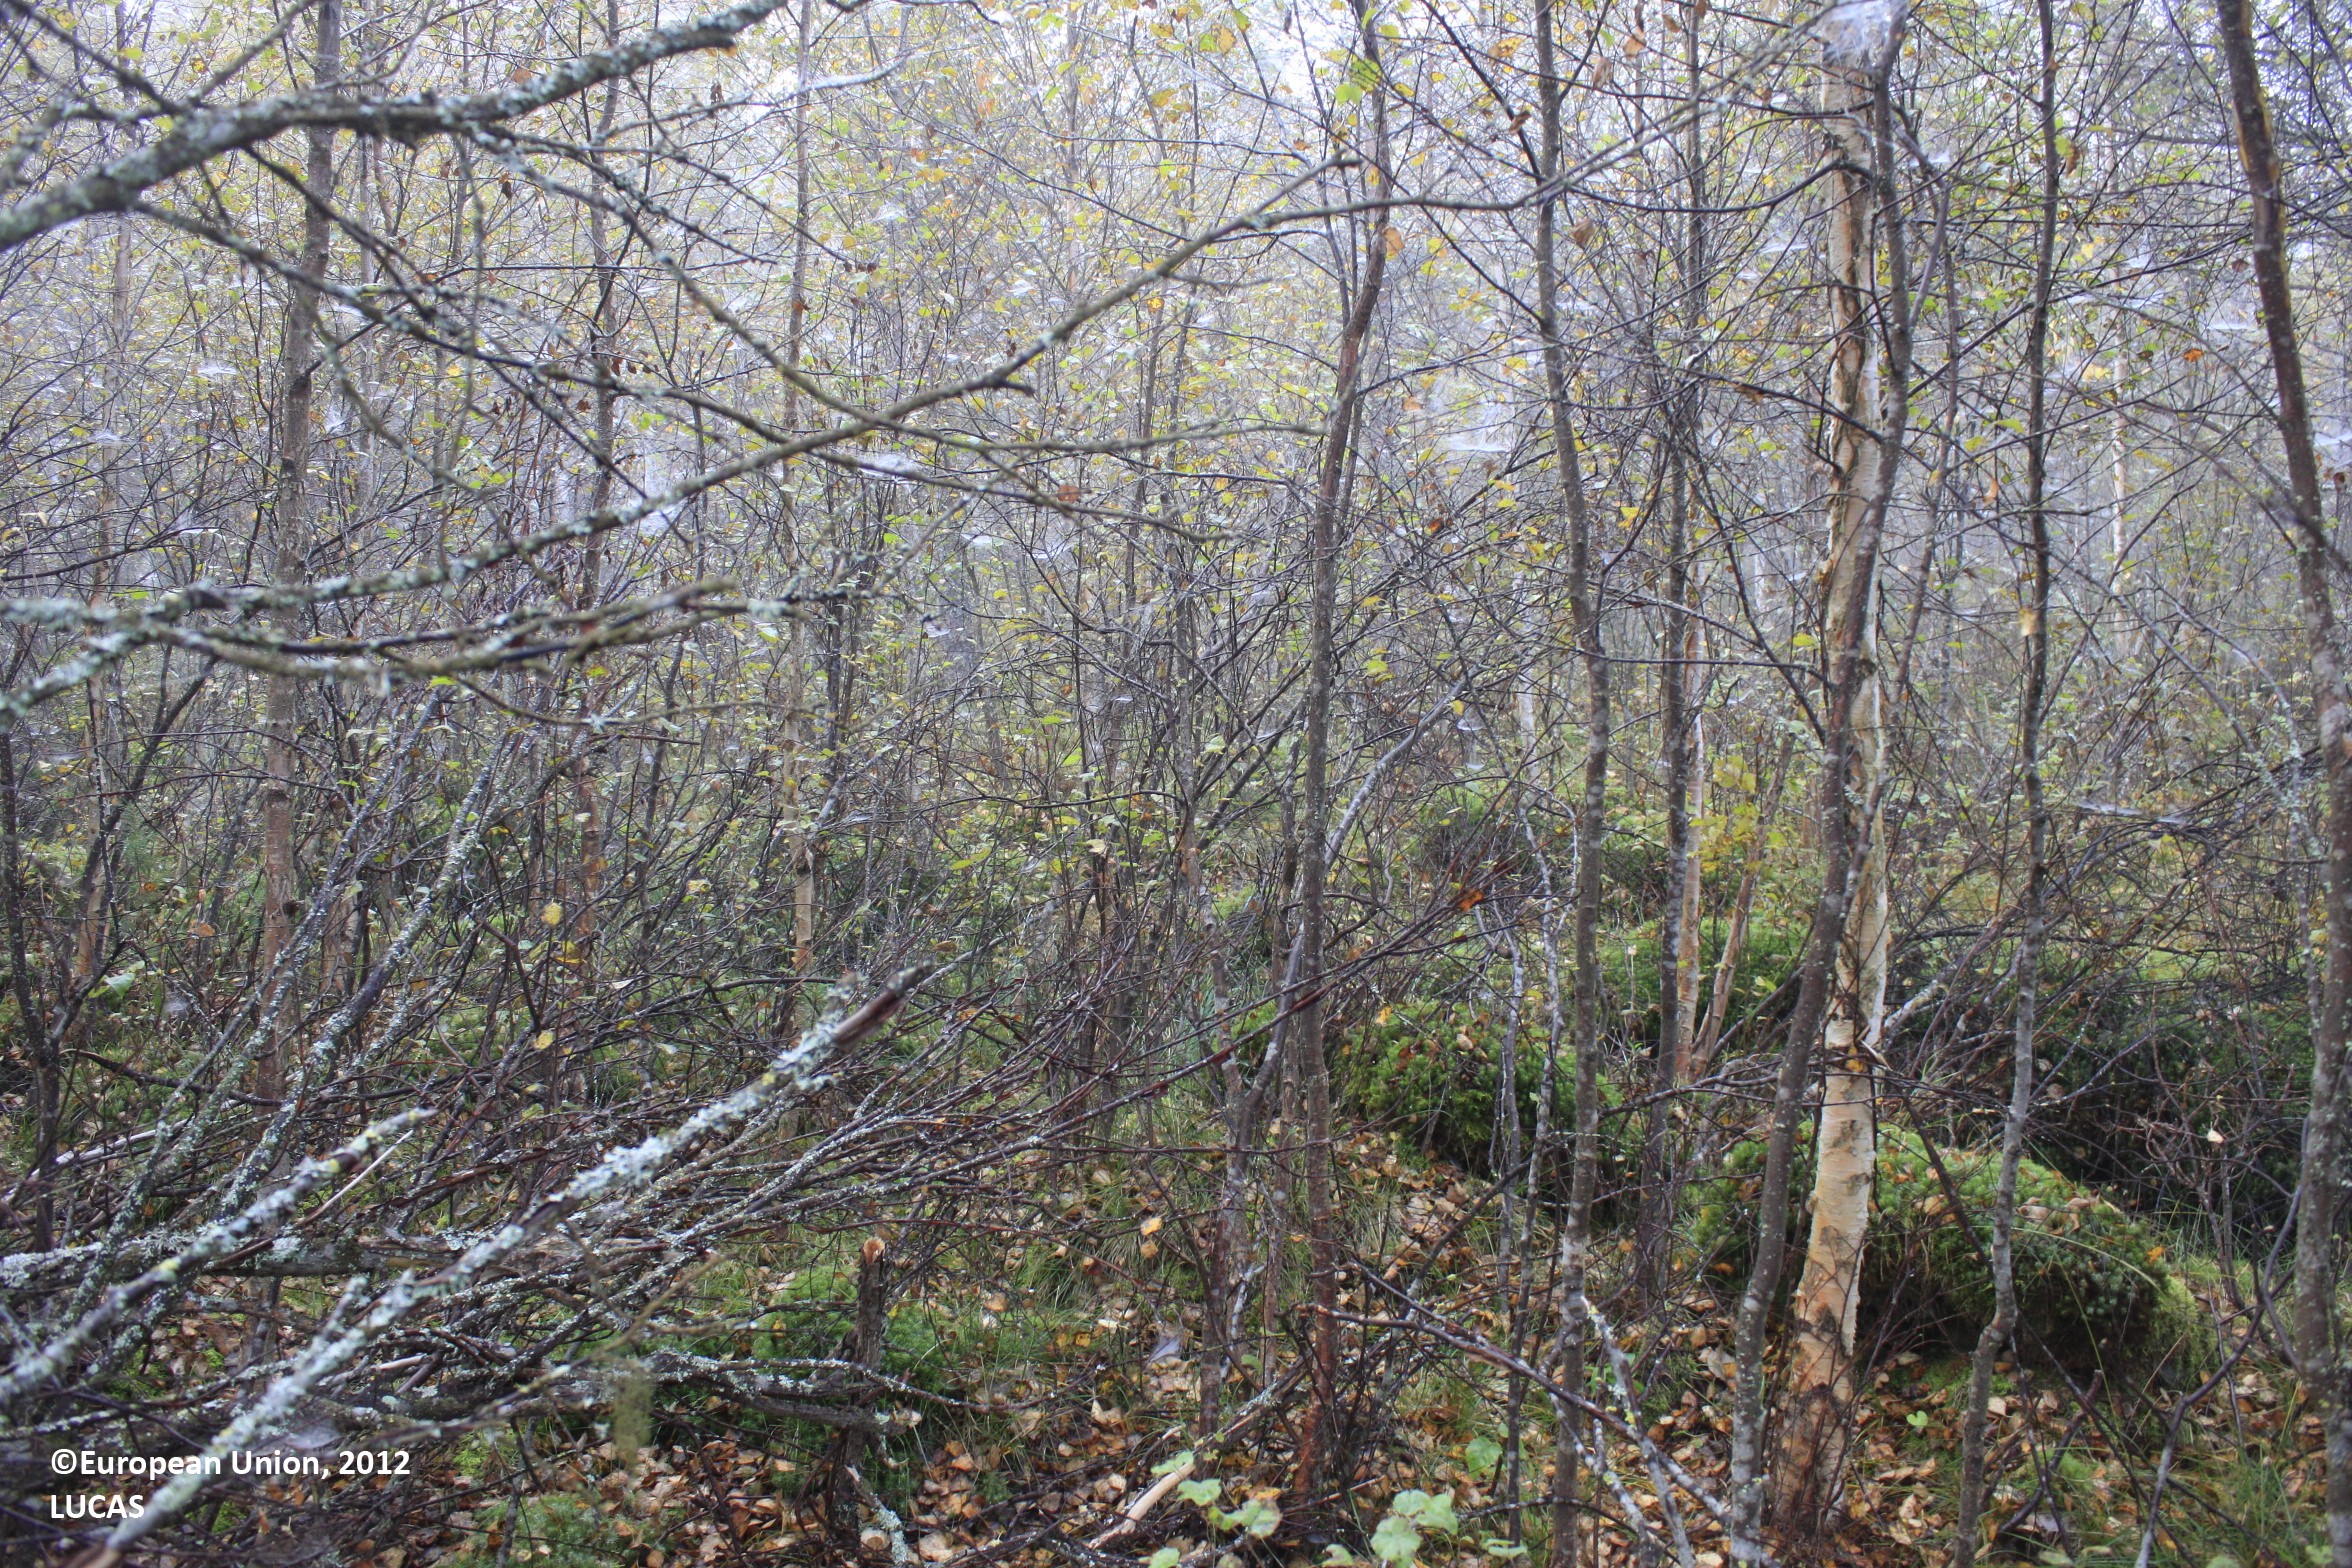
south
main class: Woodland
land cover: Broadleaved woodland
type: non-riverine alder, birch or aspen forest
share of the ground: 50 - 75 %
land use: Forestry
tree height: > 5 m
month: September
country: FI
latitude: 65.1924
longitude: 26.8837
